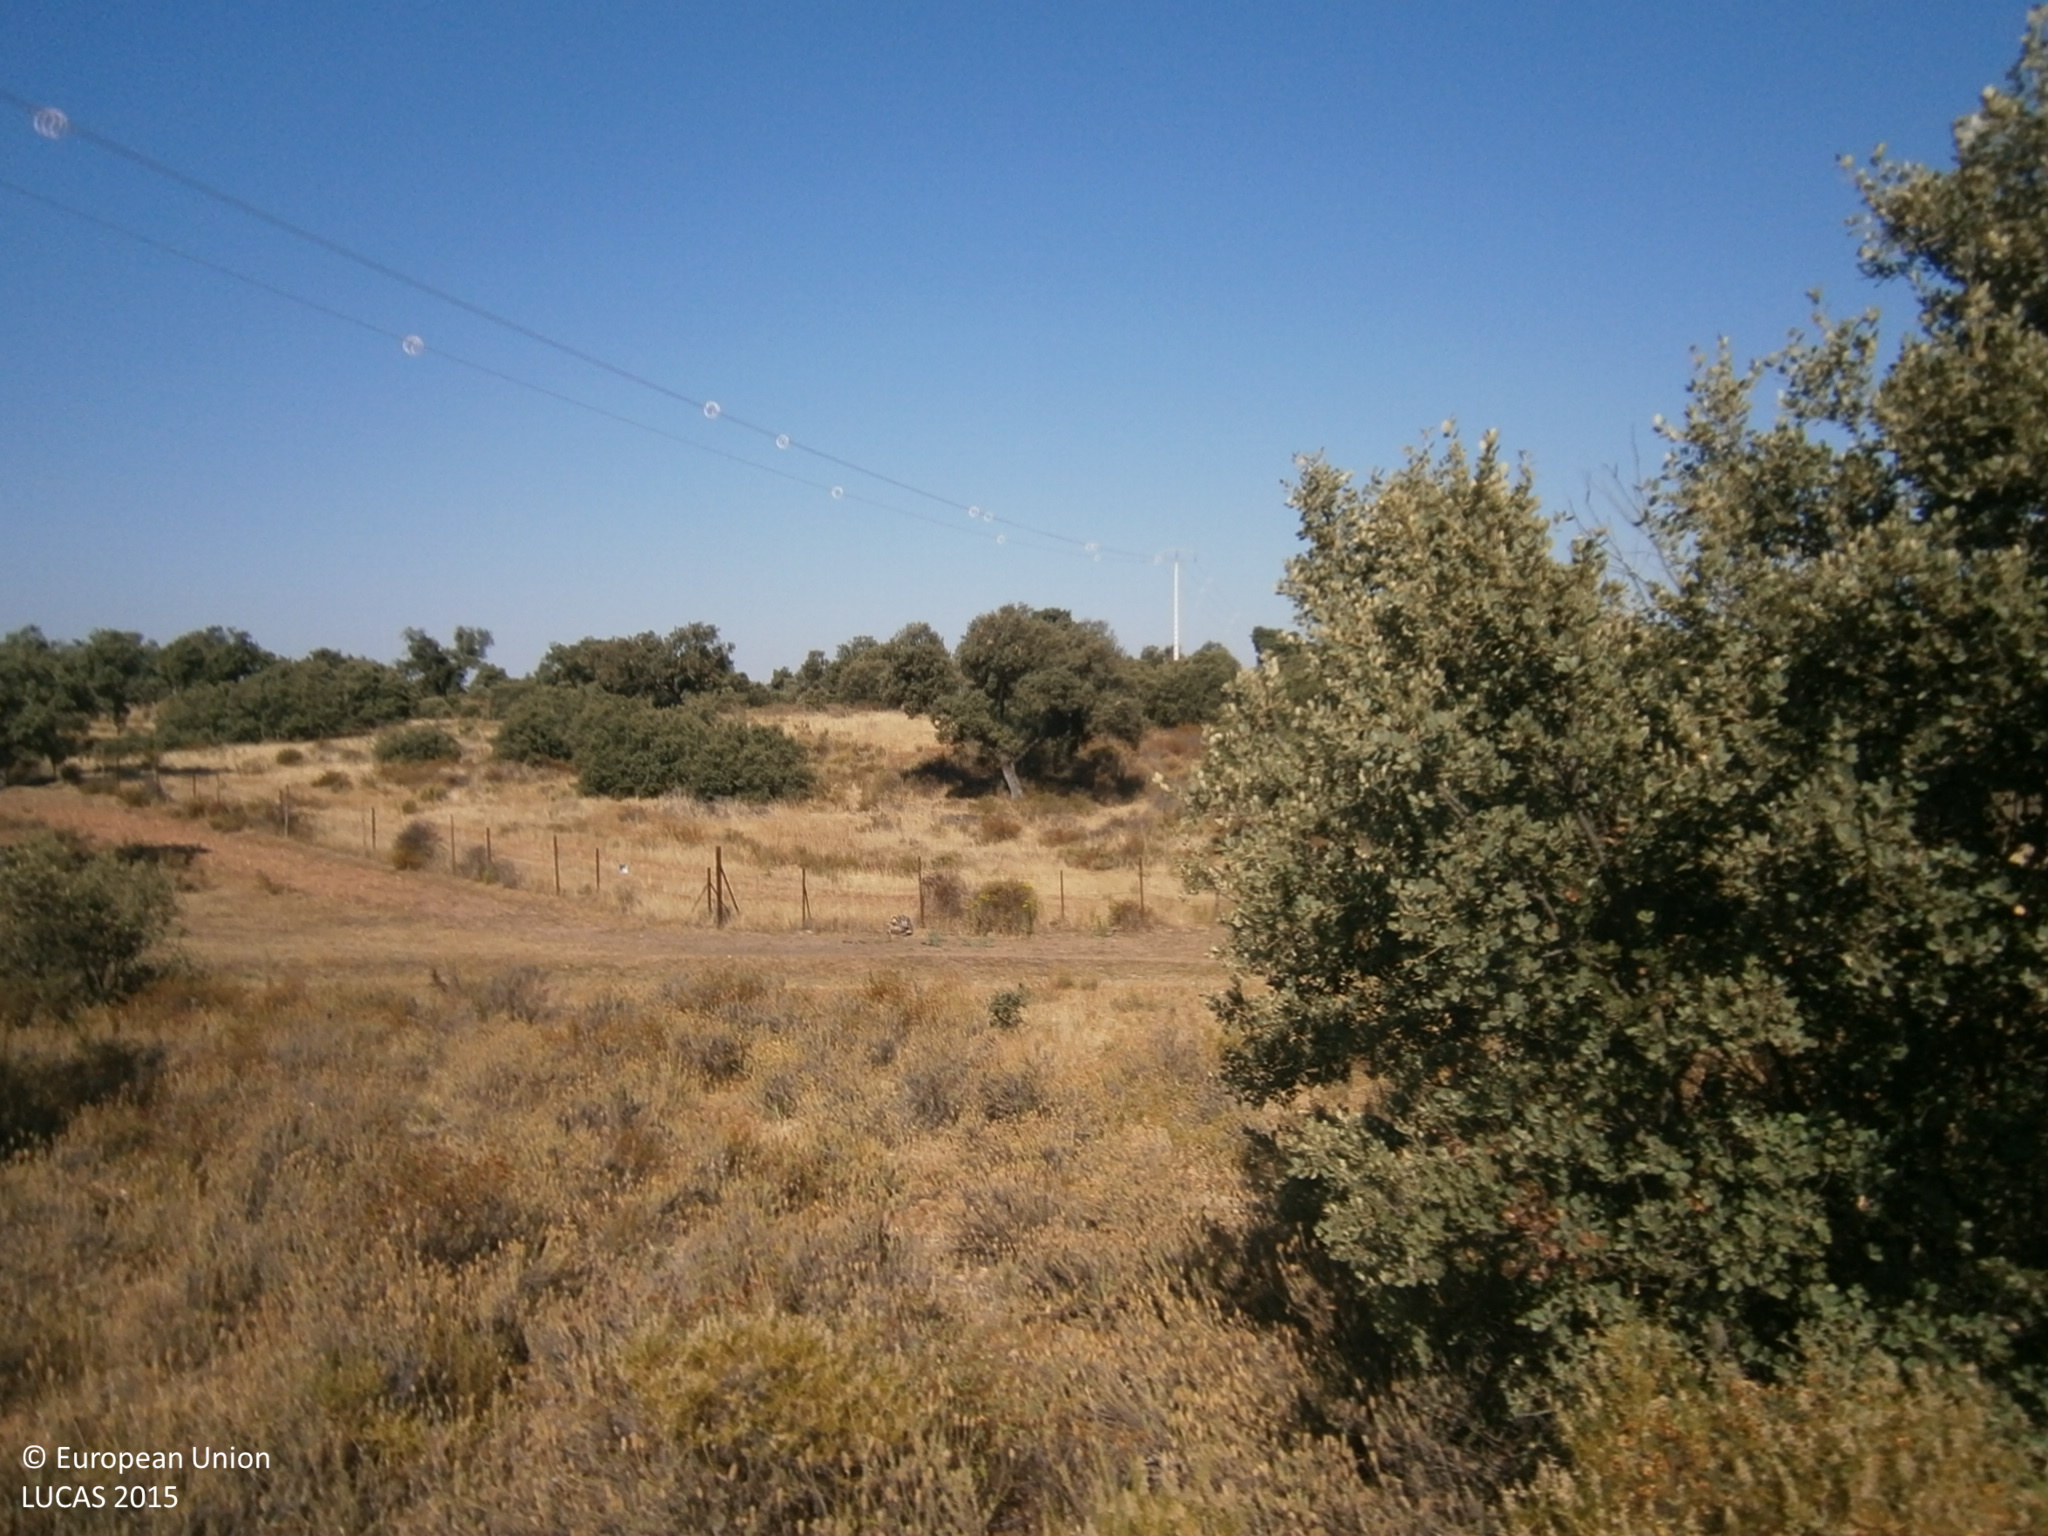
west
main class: Woodland
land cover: Broadleaved woodland
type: broadleaved evergreen forest
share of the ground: > 75 %
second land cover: Spontaneously vegetated surfaces
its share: > 75 %
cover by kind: broadleaved forest trees 90 %, unconsolidated bare surface 5 %
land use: Forestry
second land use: Agriculture (excluding fallow land and kitchen gardens)
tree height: < 5 m
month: June
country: ES
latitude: 38.8444
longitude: -6.9006
